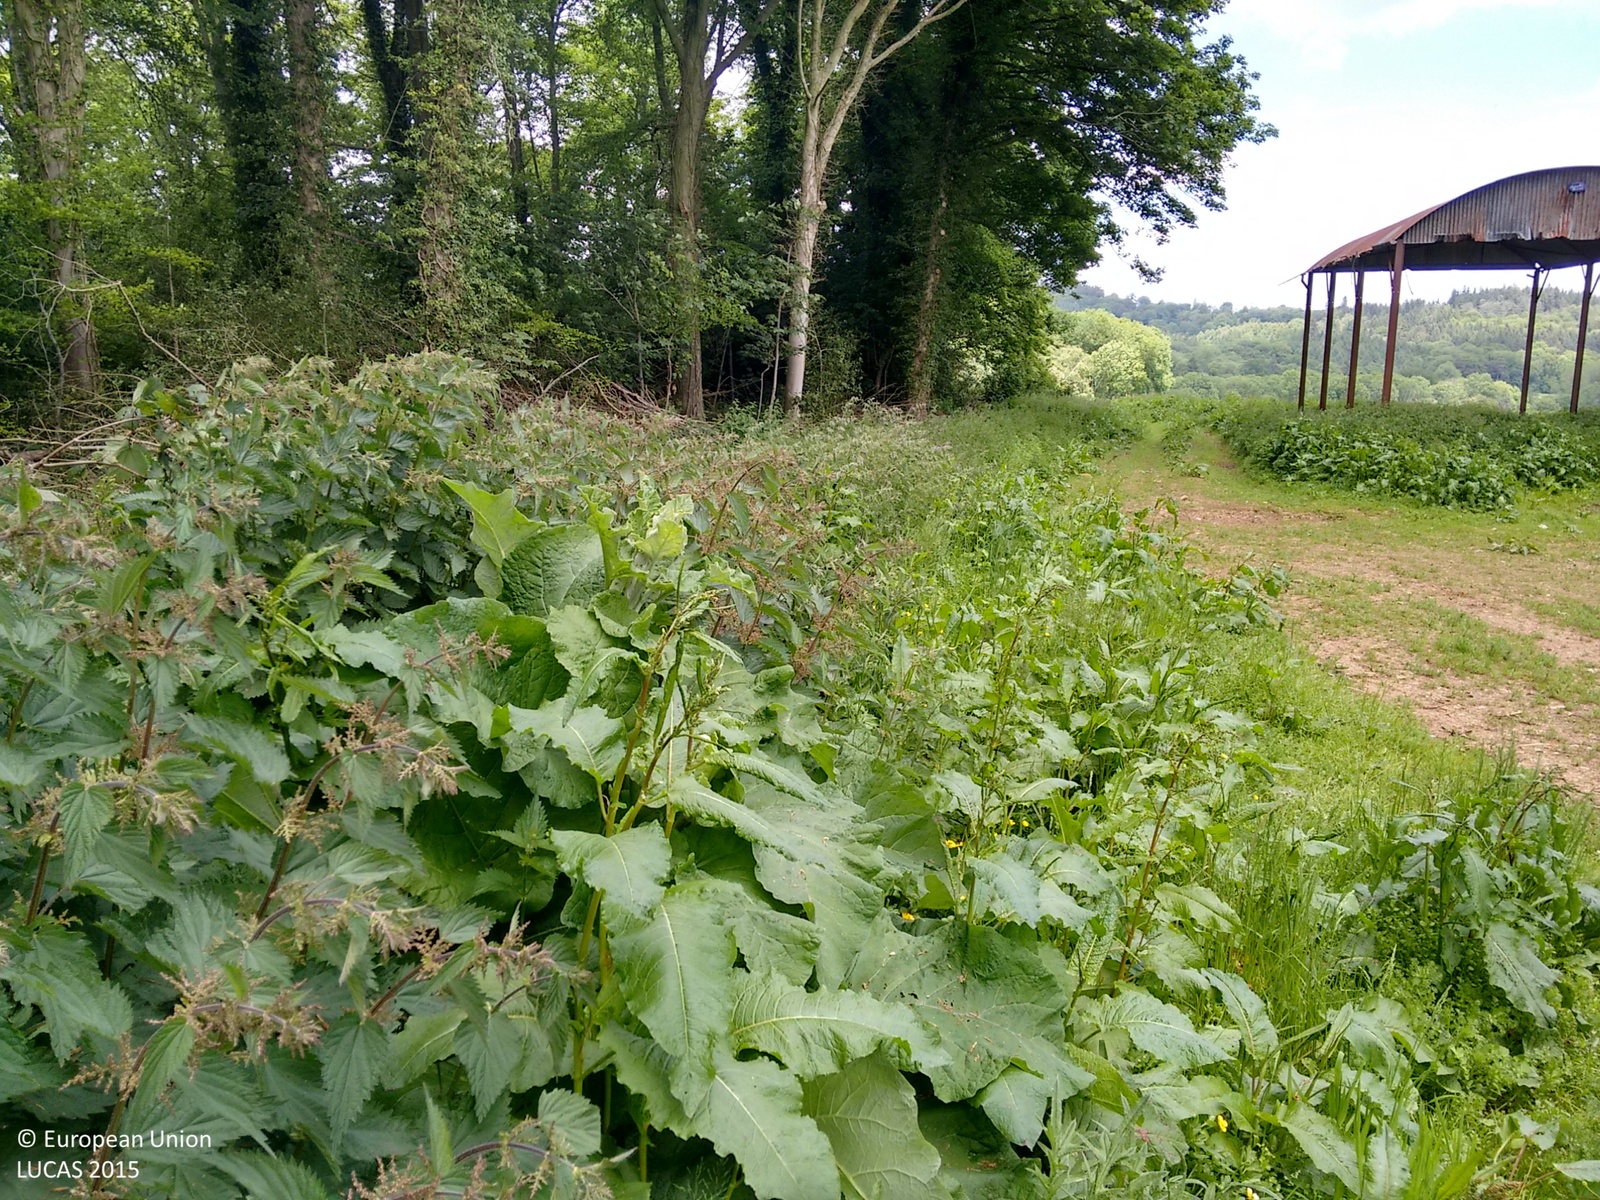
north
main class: Woodland
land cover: Broadleaved woodland
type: mesophytic deciduous forest
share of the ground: > 75 %
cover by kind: broadleaved forest trees 80 %, coniferous forest trees 20 %
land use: Semi-natural and natural areas not in use
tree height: > 5 m
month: June
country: GB
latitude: 51.0628
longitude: -2.1175
